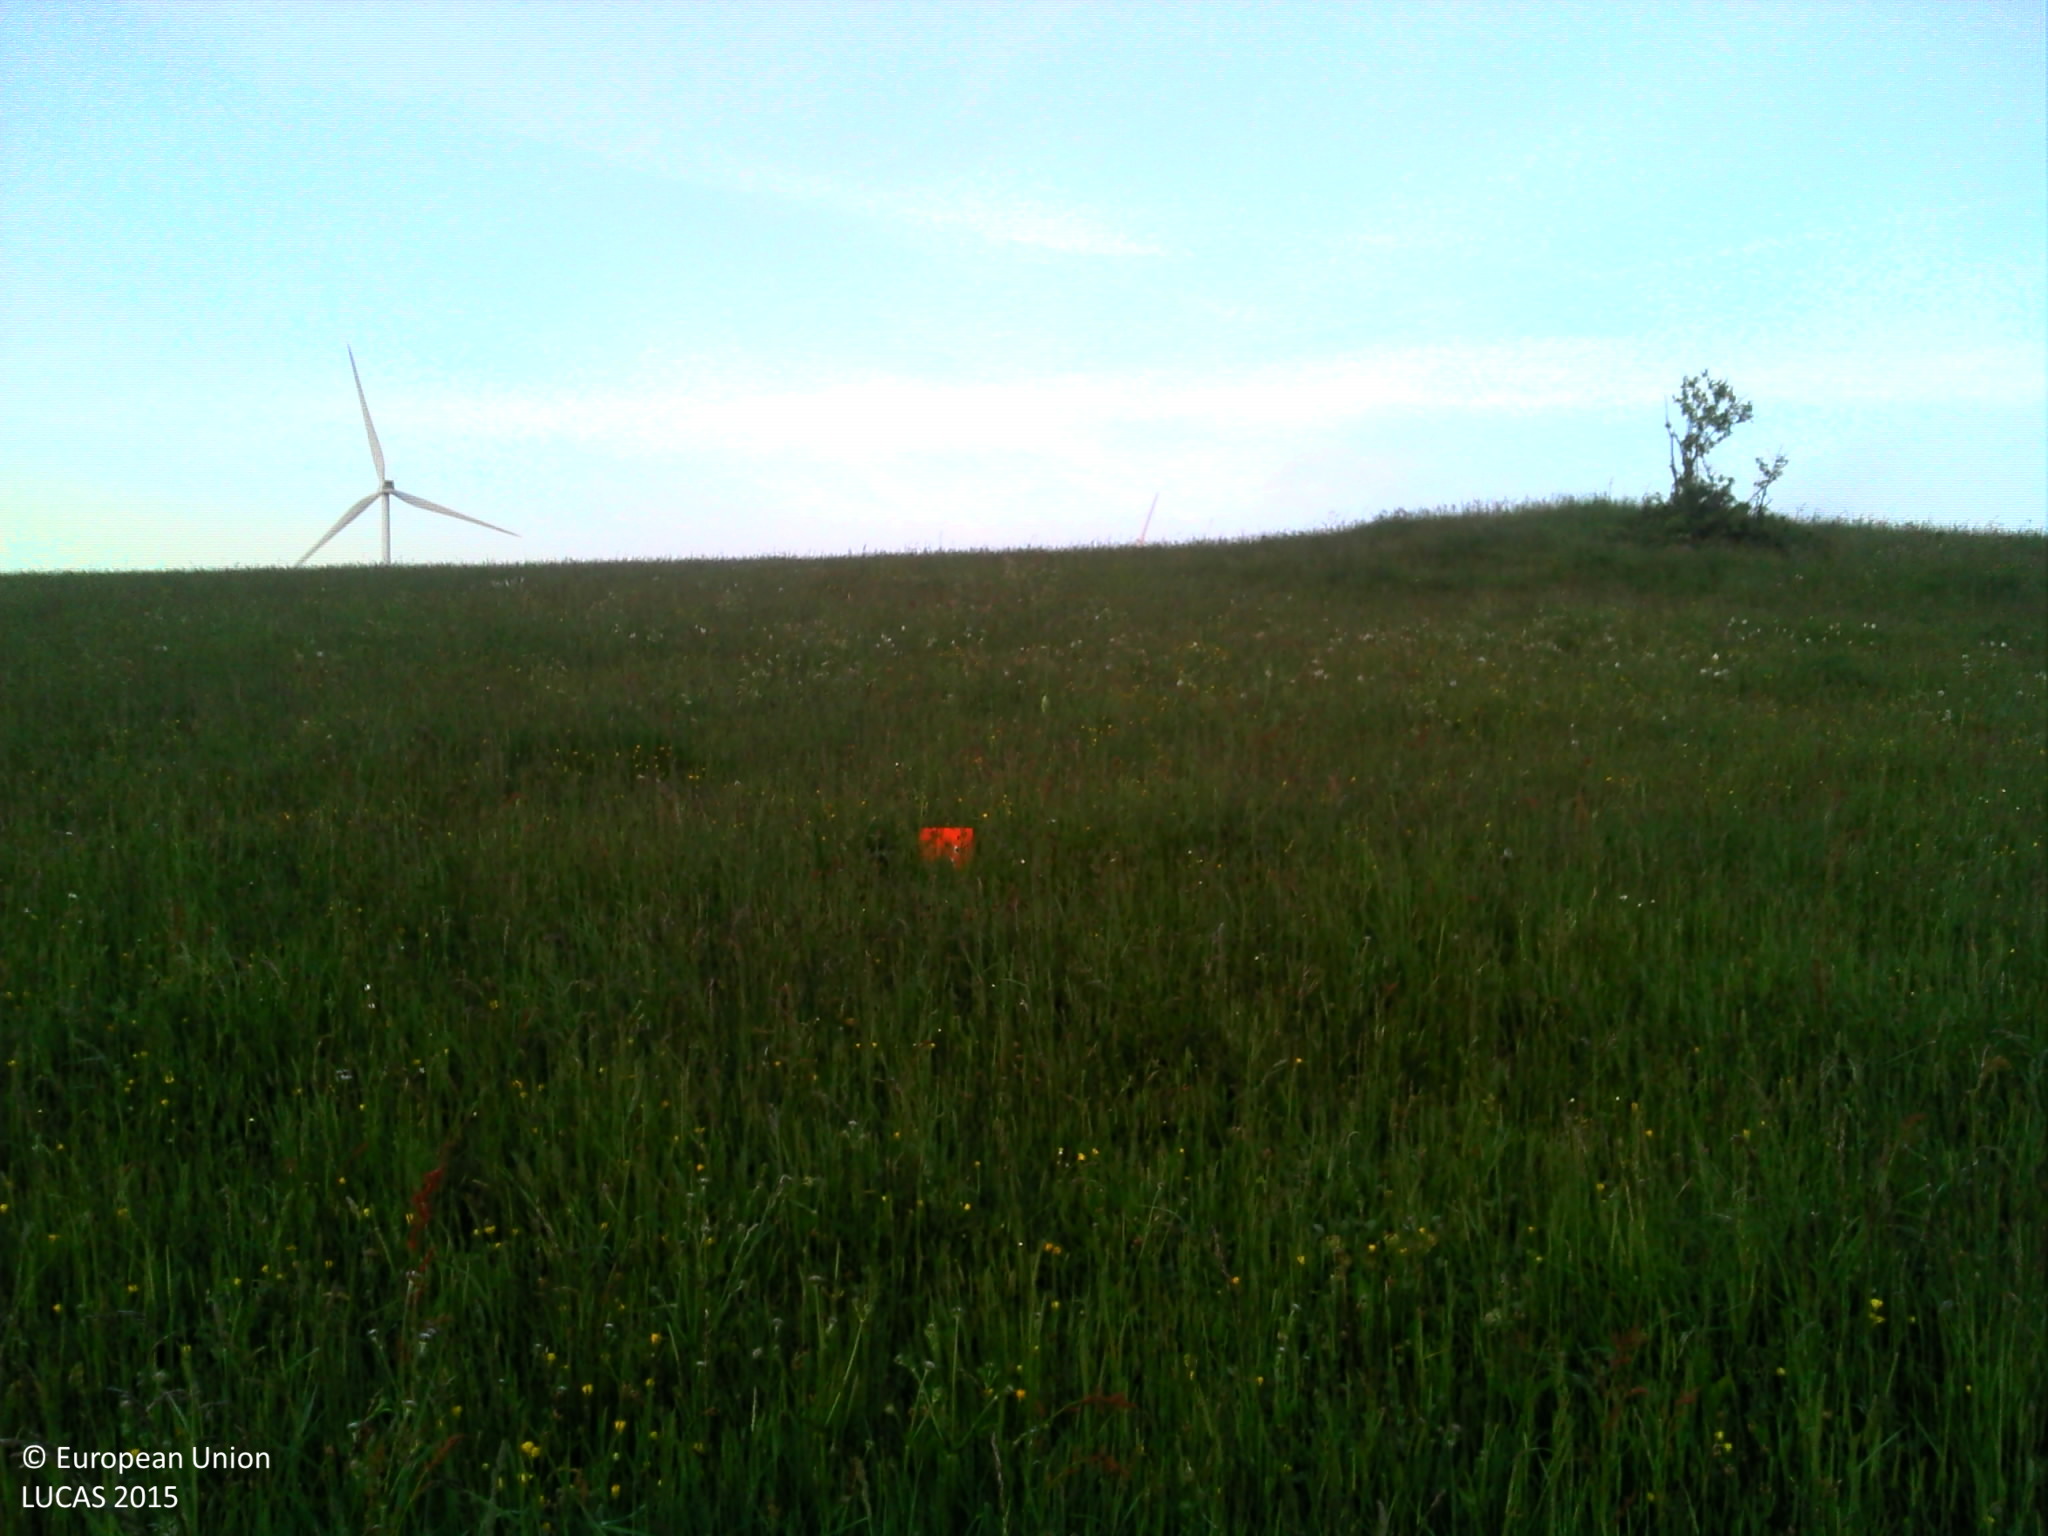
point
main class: Grassland
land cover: Grassland without tree/shrub cover
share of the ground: > 75 %
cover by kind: herbaceous plants 100 %
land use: Agriculture (excluding fallow land and kitchen gardens)
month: May
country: FR
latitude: 45.1174
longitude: 3.1250
